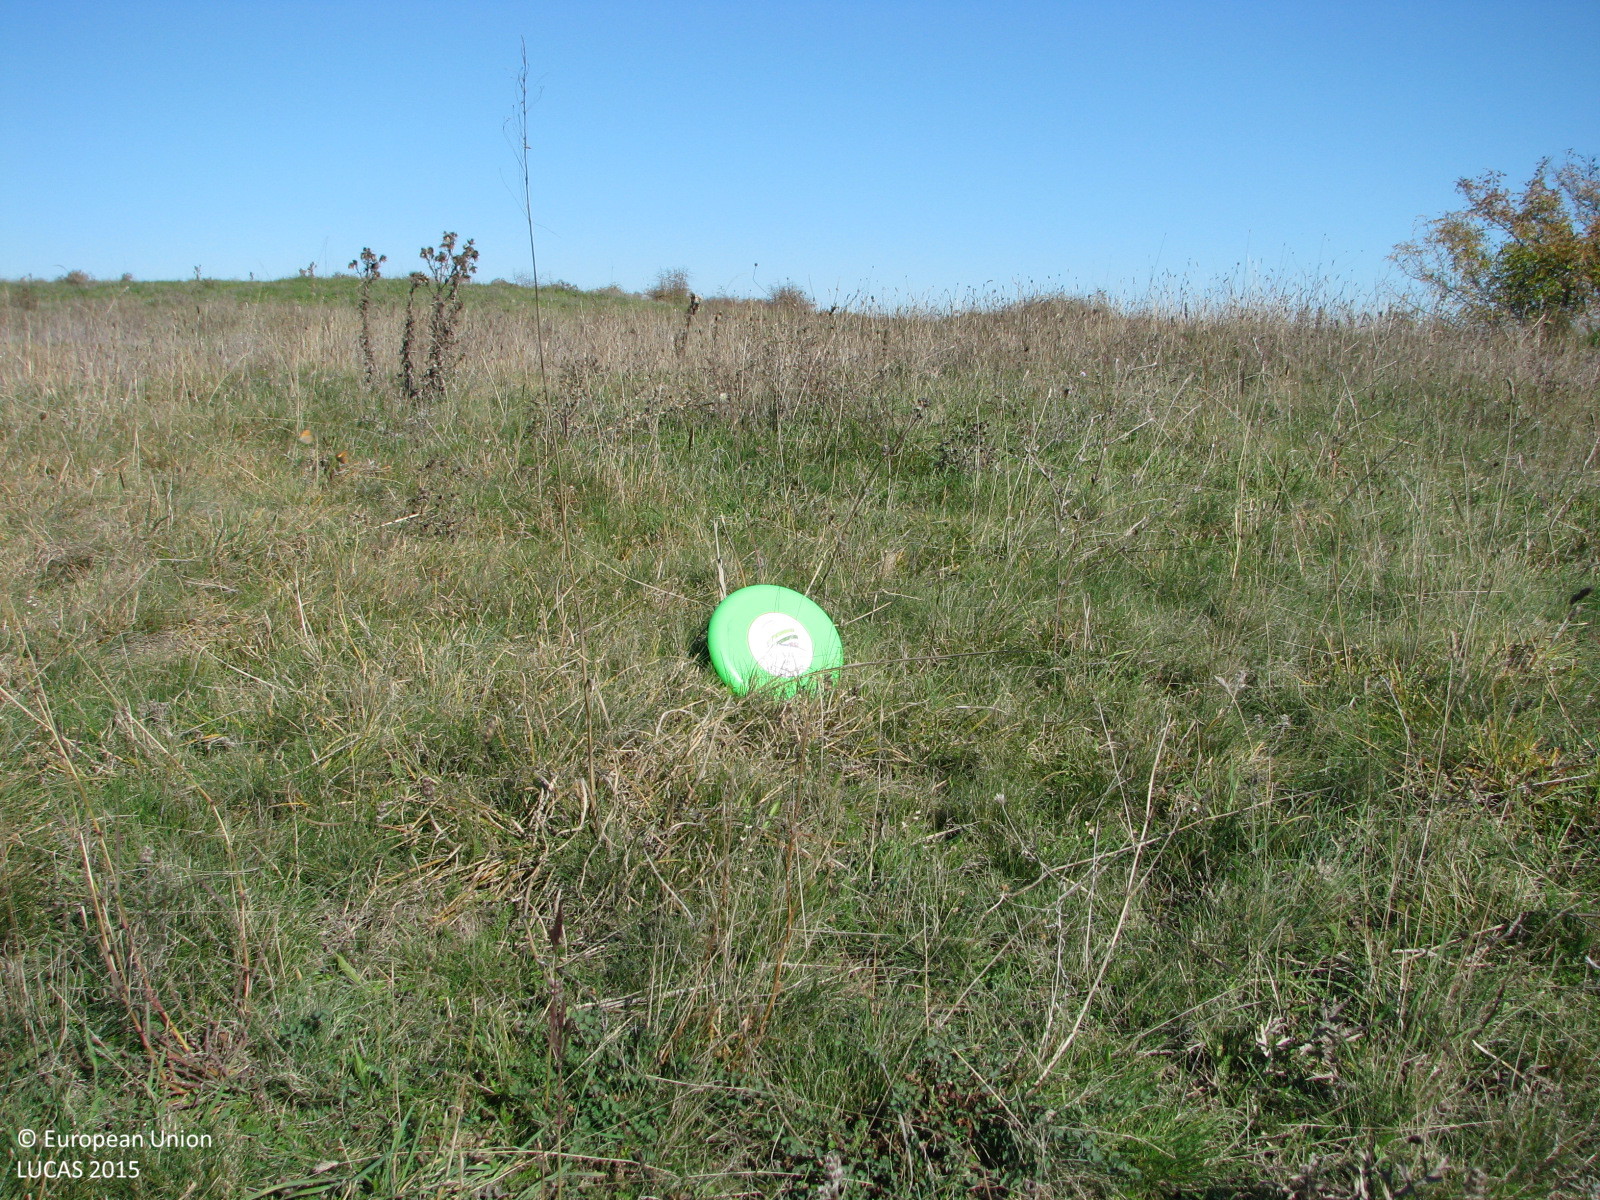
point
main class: Grassland
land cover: Grassland without tree/shrub cover
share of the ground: > 75 %
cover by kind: herbaceous plants 95 %, shrubs 5 %
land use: Agriculture (excluding fallow land and kitchen gardens)
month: November
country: BG
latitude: 42.0723
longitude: 26.6611
